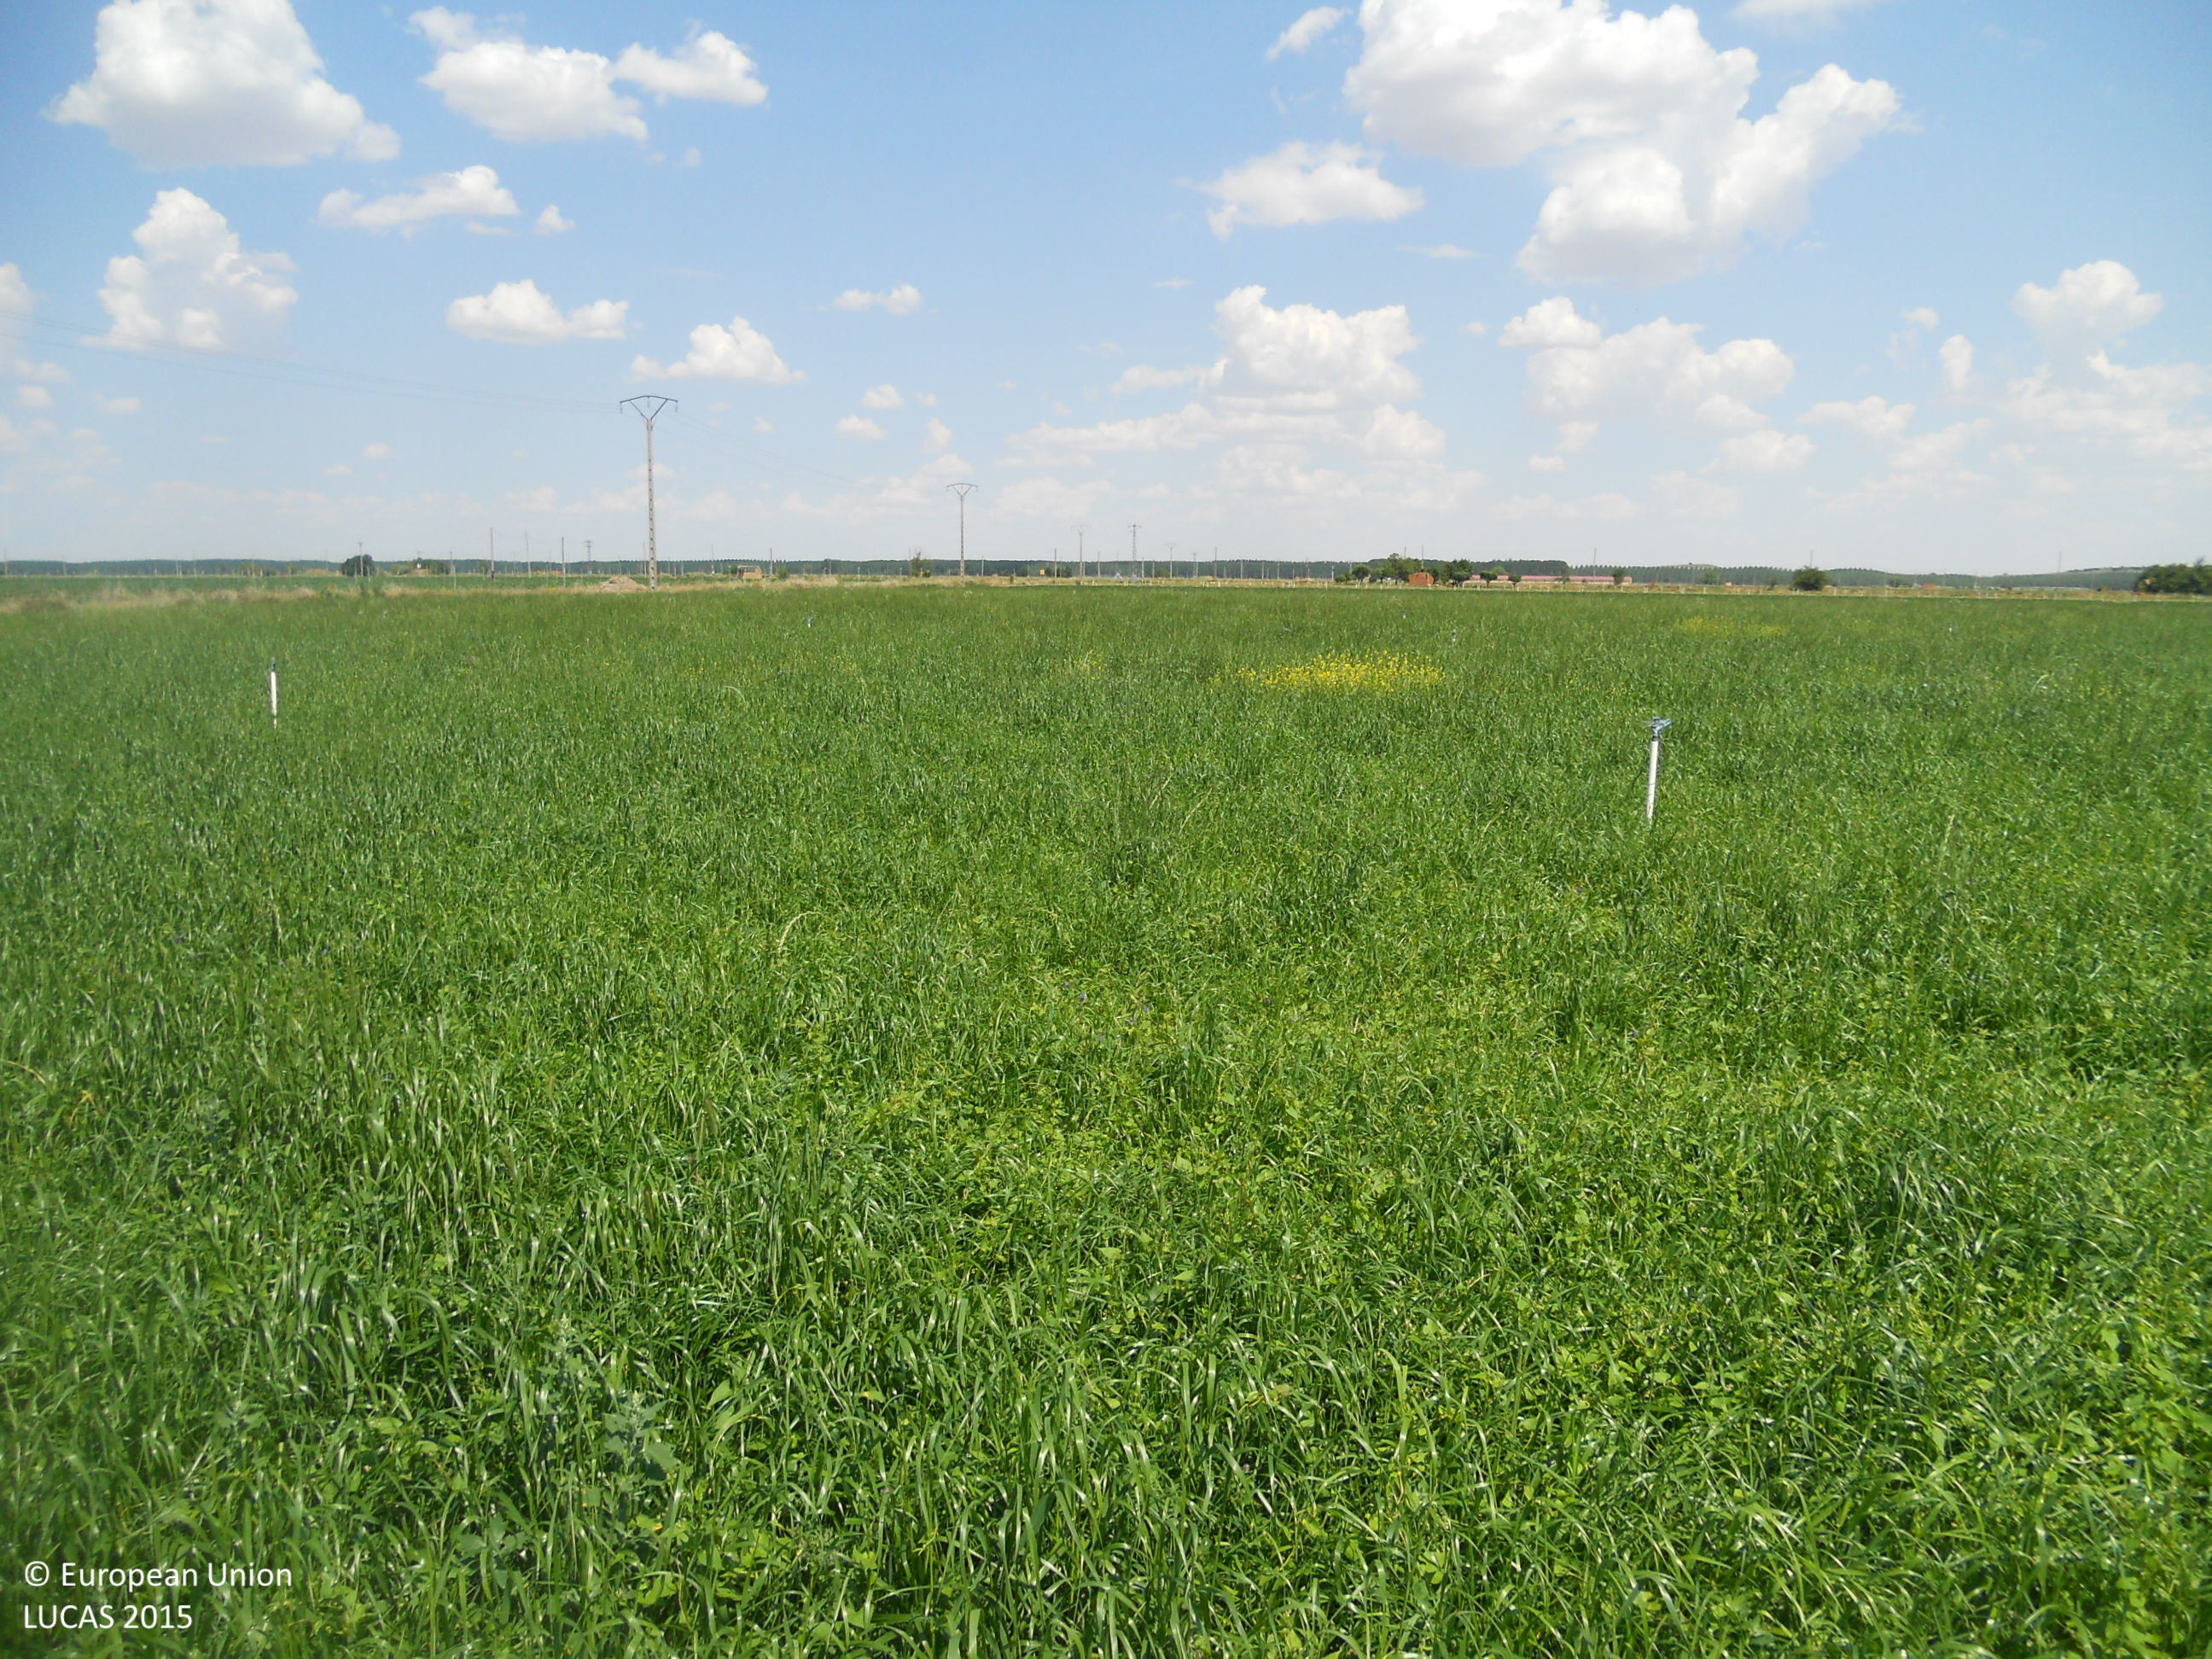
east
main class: Cropland
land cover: Temporary grasslands
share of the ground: > 75 %
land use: Agriculture (excluding fallow land and kitchen gardens)
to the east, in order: Temporary grasslands; Grass margins; Tracks; Grass margins; Maize; Grass margins; Lucerne
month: June
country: ES
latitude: 42.2379
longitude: -5.6415
